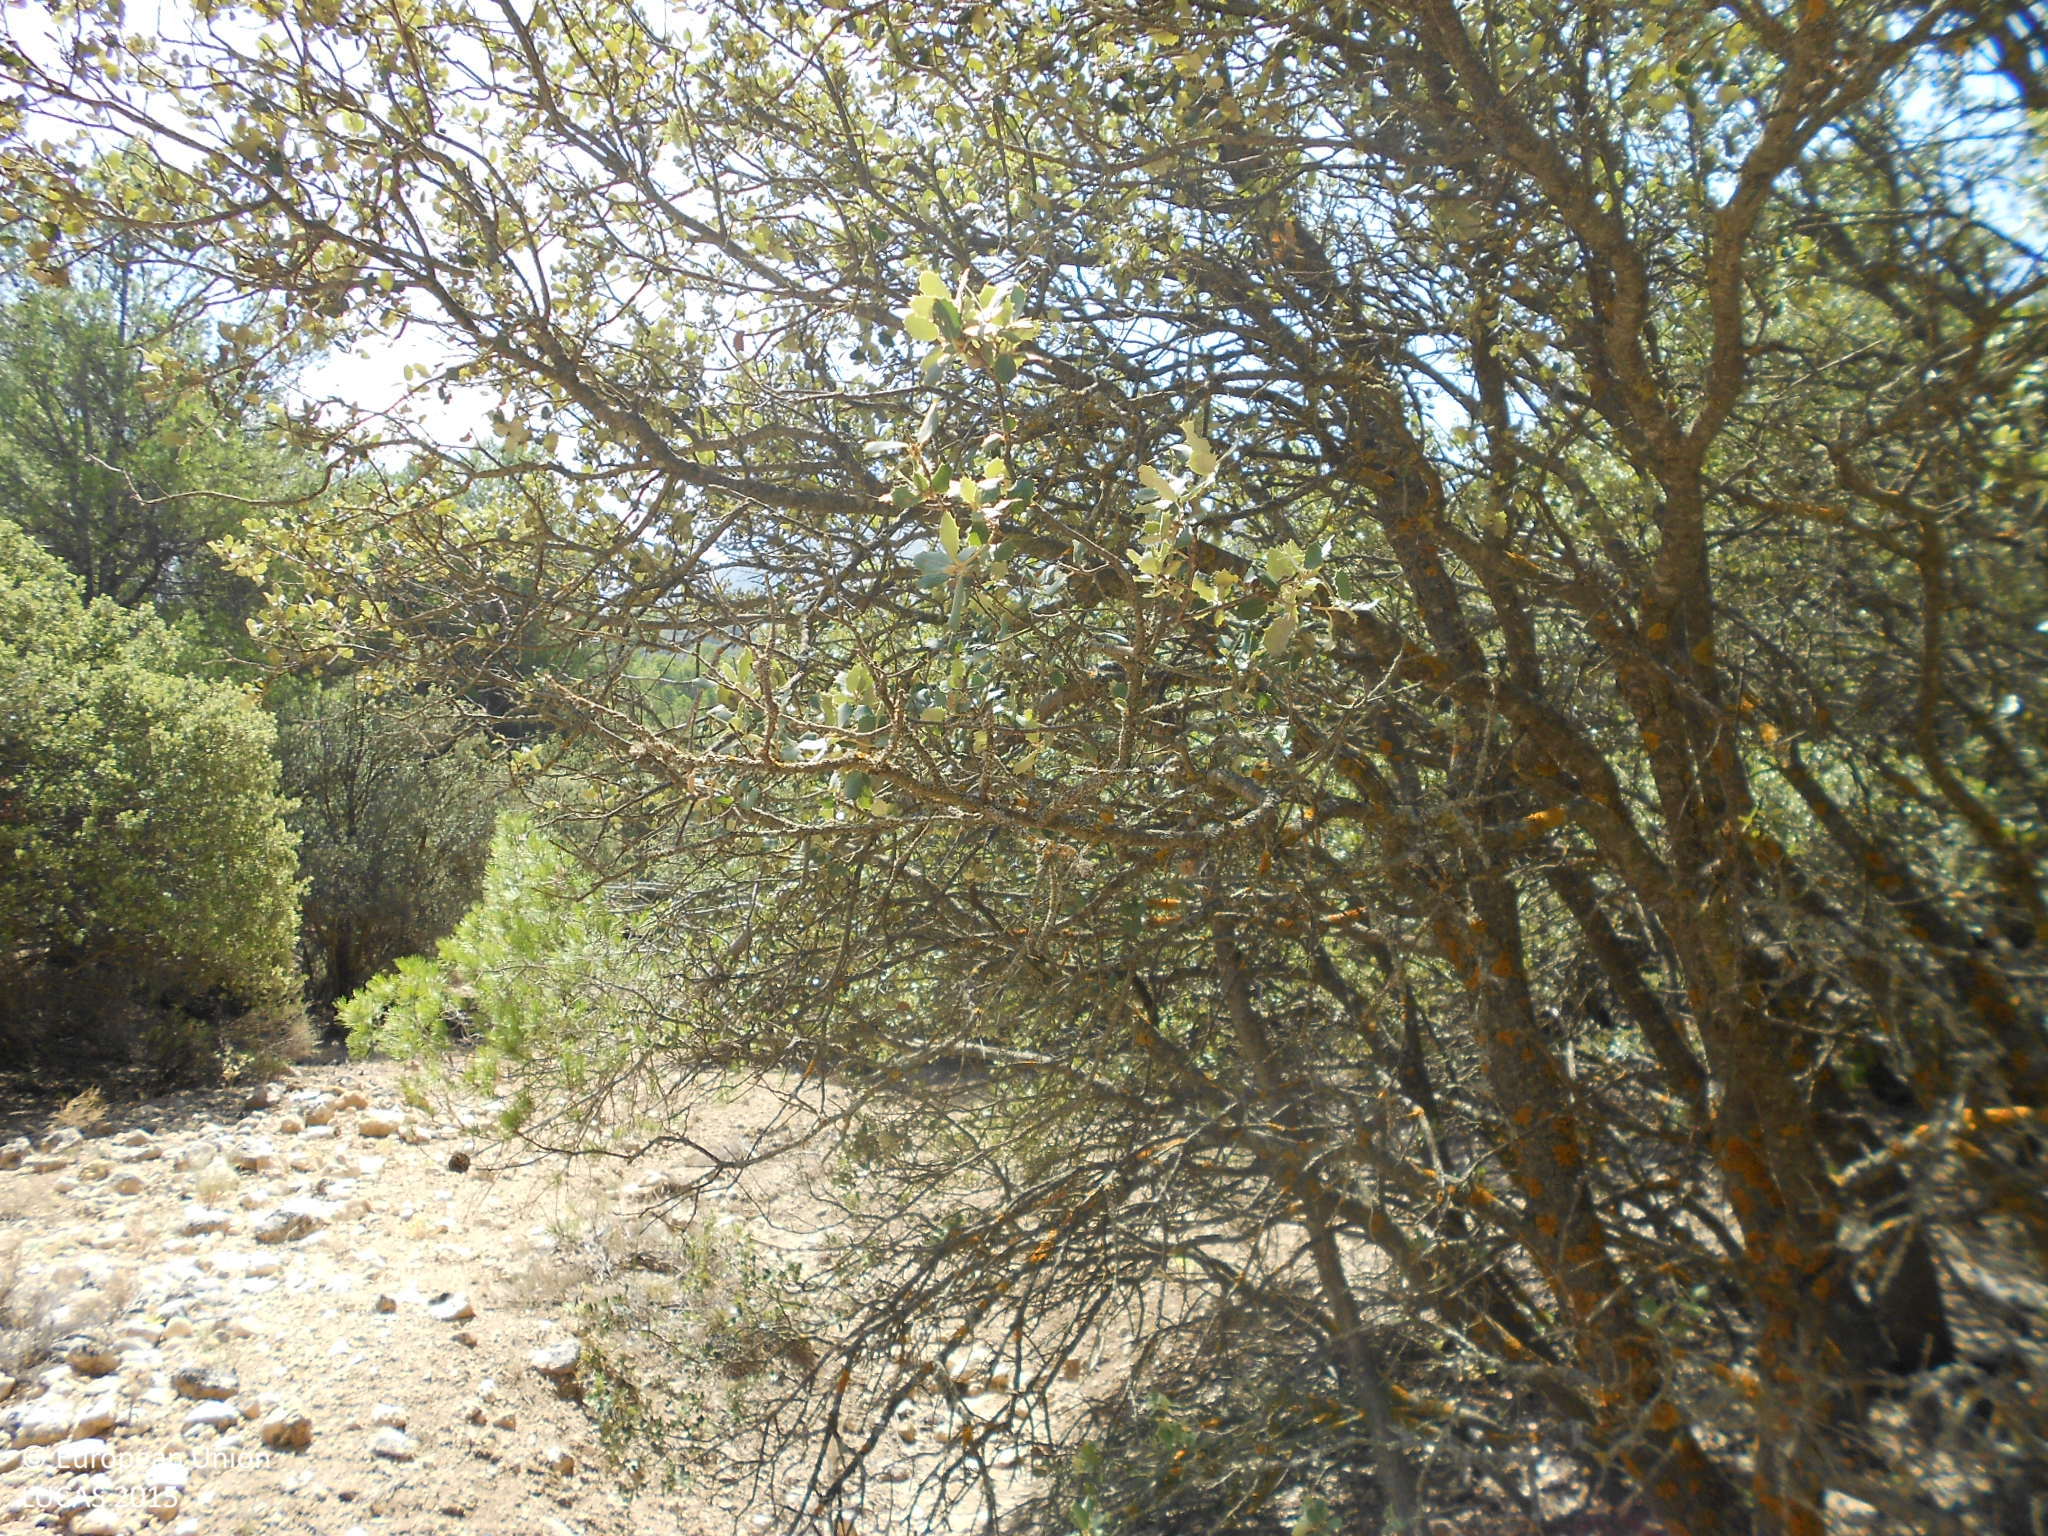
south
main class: Woodland
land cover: Other mixed woodland
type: coniferous forest of the mediterranean region
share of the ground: > 75 %
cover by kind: coniferous forest trees 40 %, broadleaved forest trees 40 %, shrubs 20 %
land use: Semi-natural and natural areas not in use
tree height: > 5 m
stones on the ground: 25 - 50 %
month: August
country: ES
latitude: 37.6859
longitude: -2.2443
